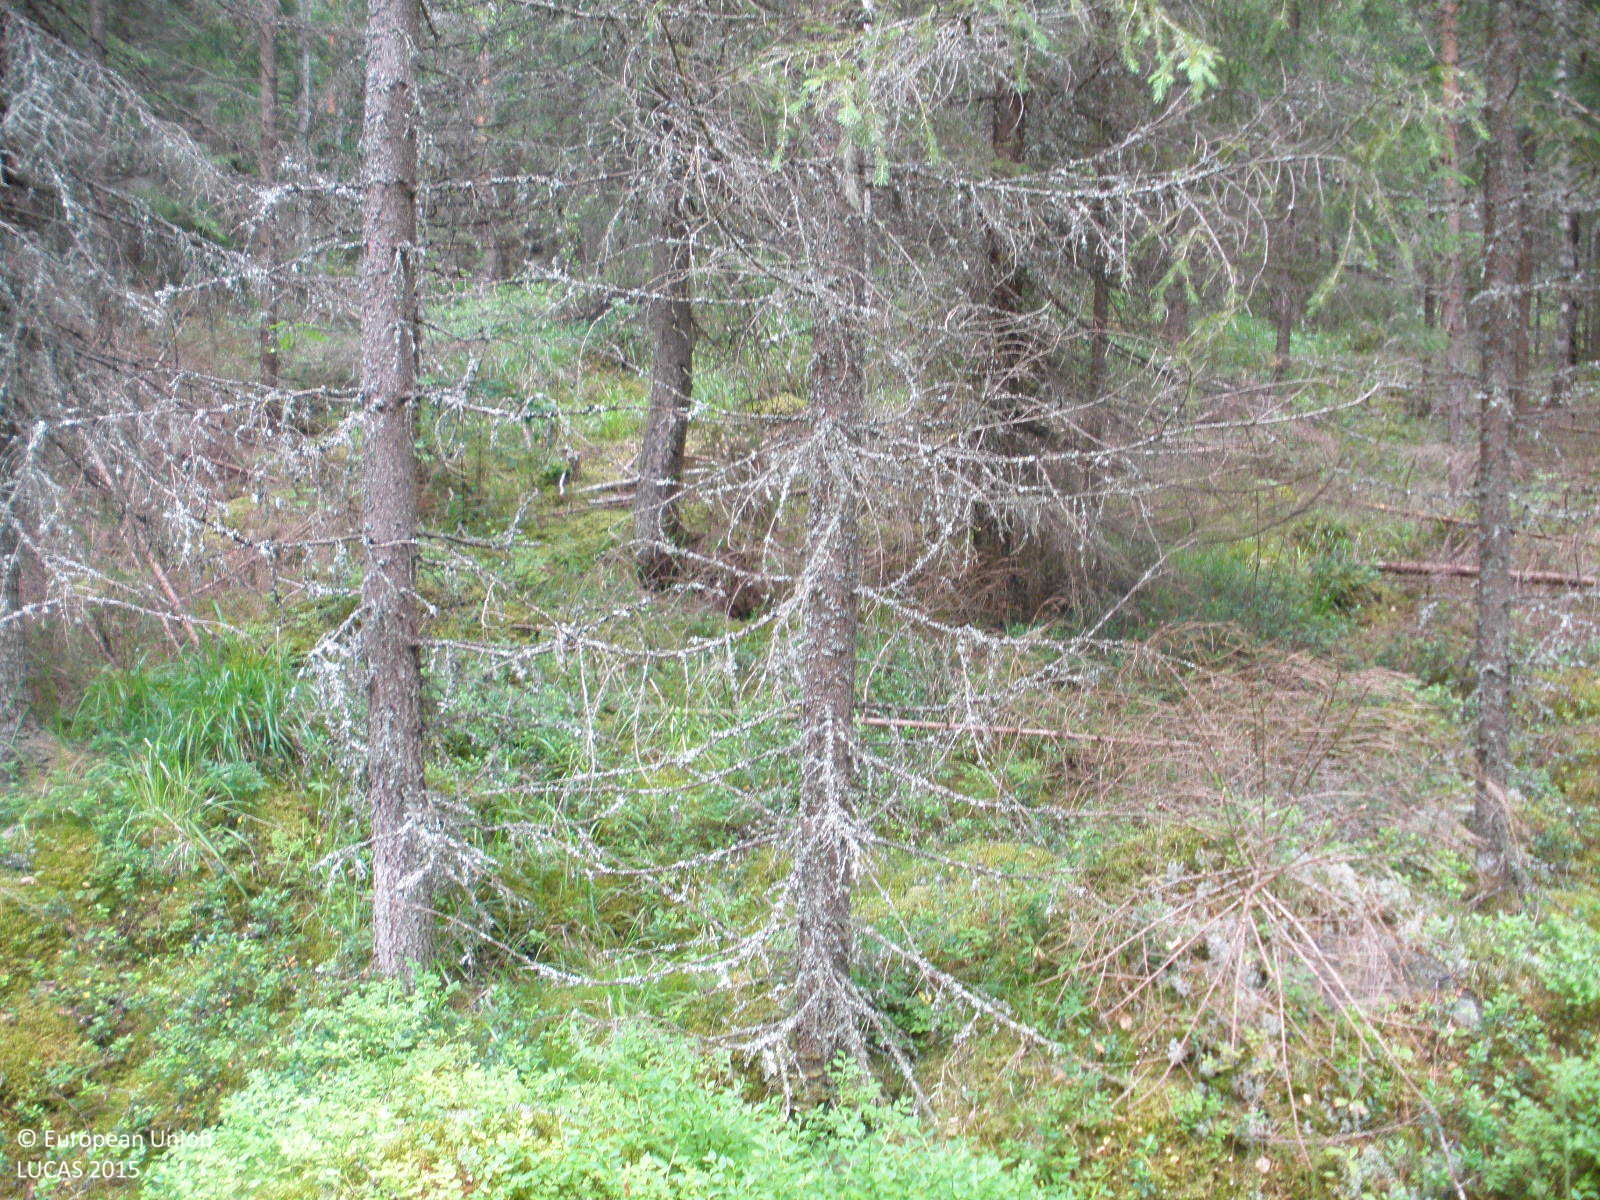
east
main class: Woodland
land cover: Spruce dominated coniferous woodland
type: boreal forest
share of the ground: > 75 %
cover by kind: coniferous forest trees 85 %, lichens and mosses 10 %, herbaceous plants 5 %
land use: Forestry
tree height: > 5 m
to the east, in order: Spruce dominated coniferous woodland; Spruce dominated mixed woodland; Spruce dominated coniferous woodland; Tracks; Spruce dominated coniferous woodland
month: July
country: FI
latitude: 61.4551
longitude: 24.9475
